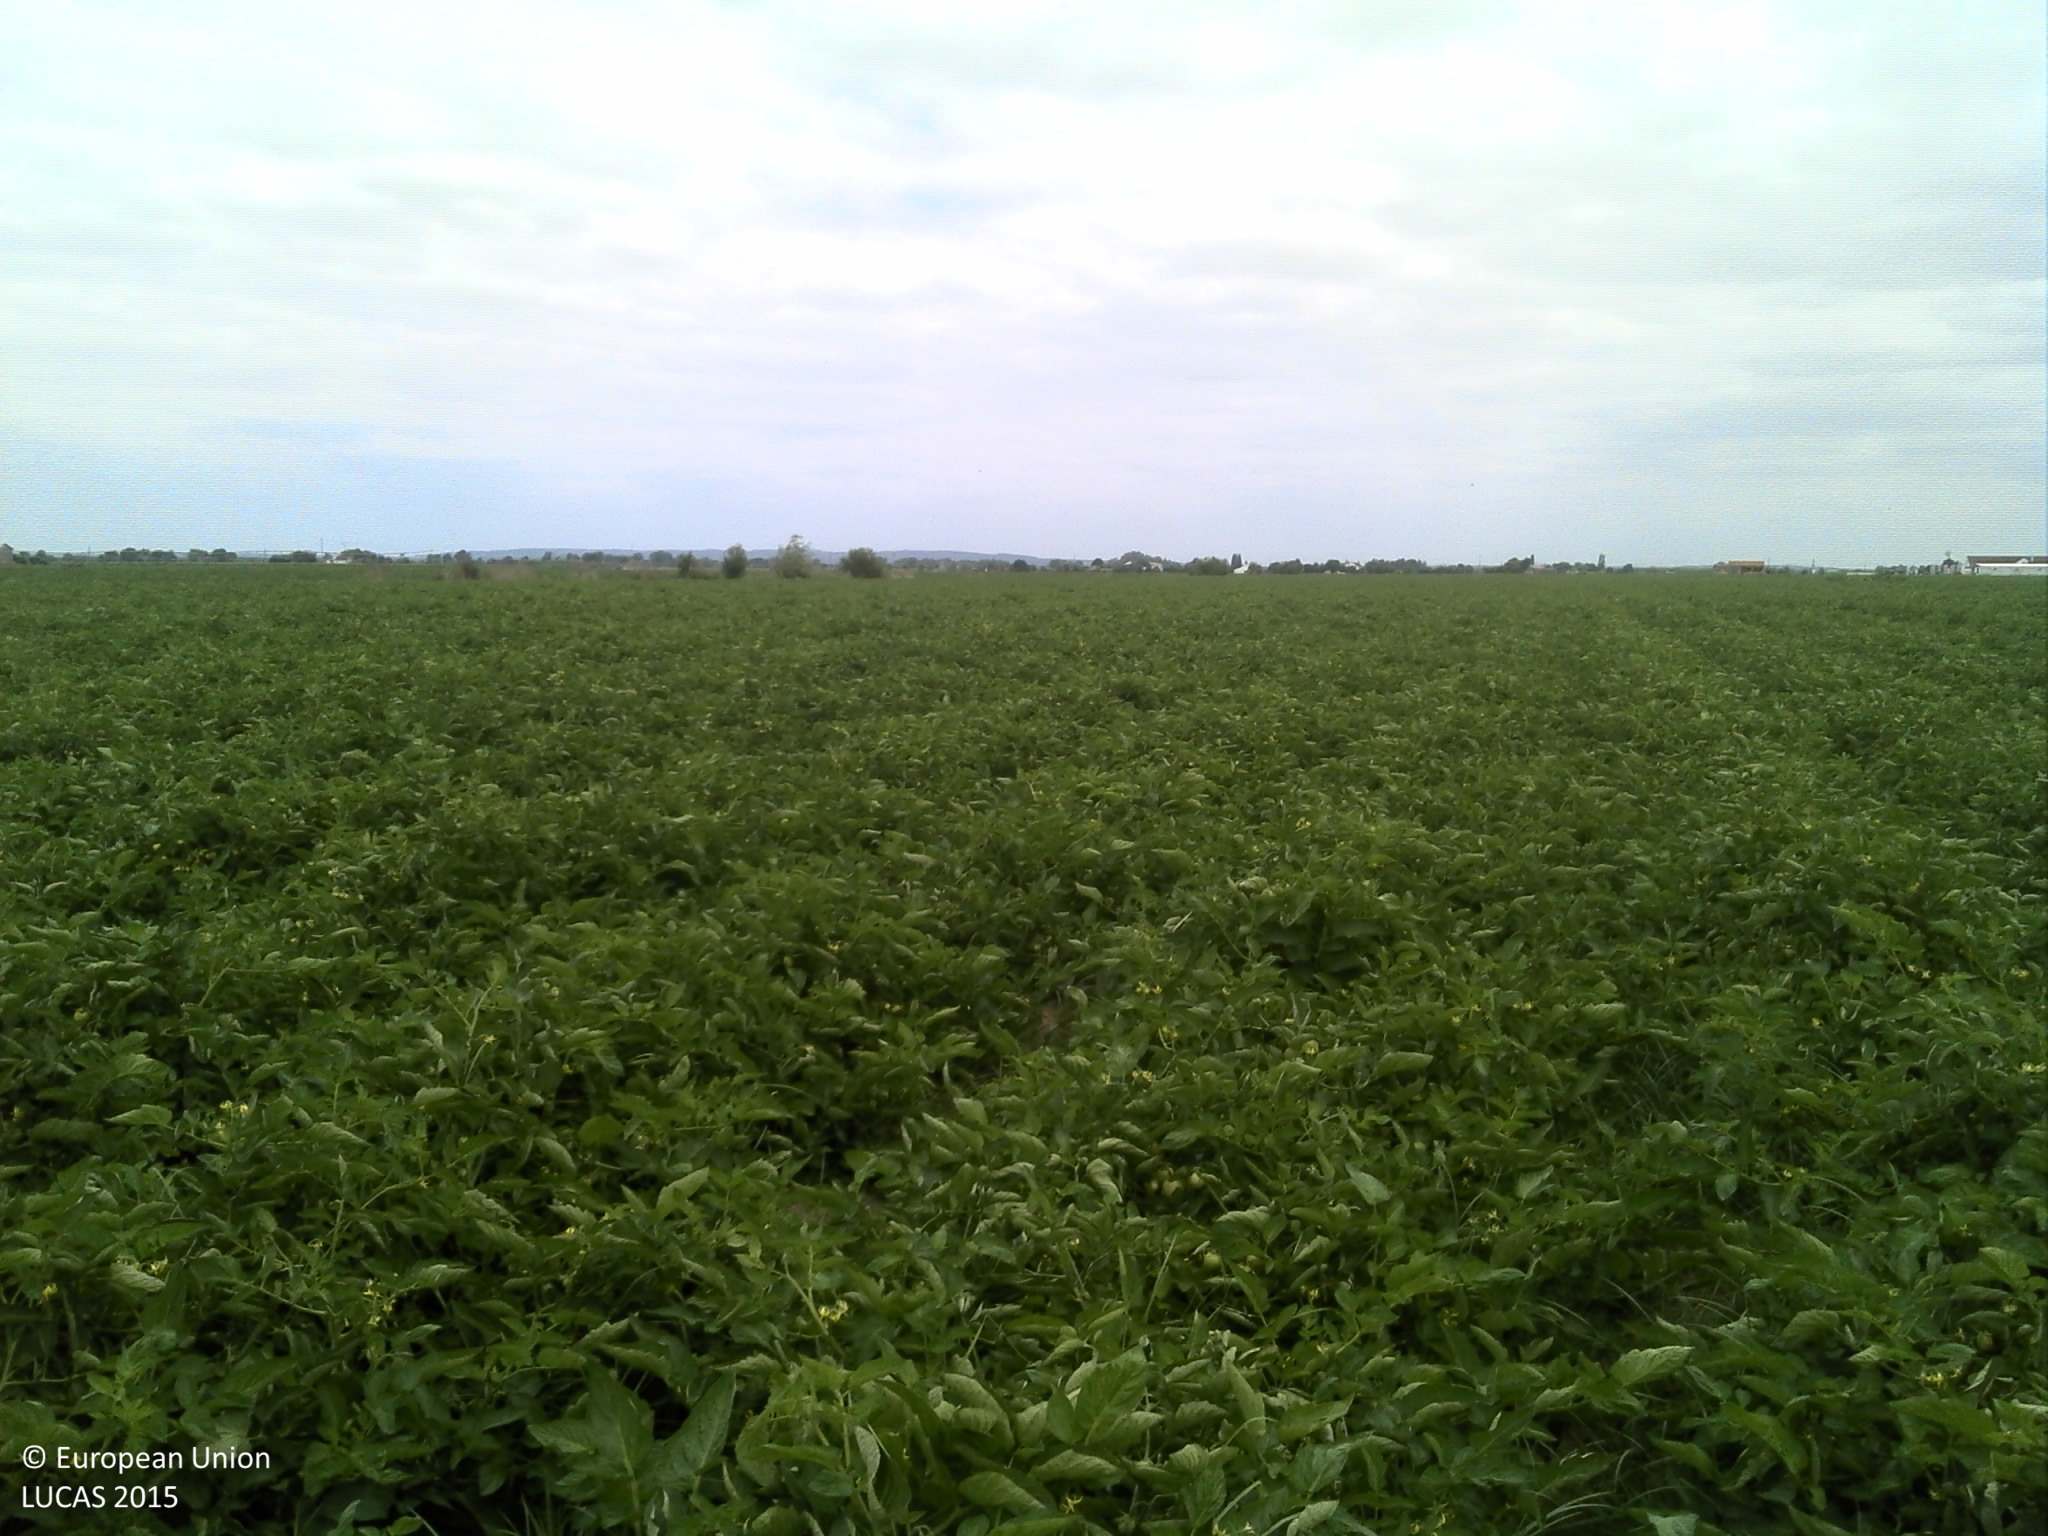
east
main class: Cropland
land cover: Tomatoes
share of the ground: > 75 %
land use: Agriculture (excluding fallow land and kitchen gardens)
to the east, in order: Tomatoes; Grass margins; Tracks; Ditches and canals; Grass margins; Tomatoes
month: June
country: PT
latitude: 39.1651
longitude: -8.7410
